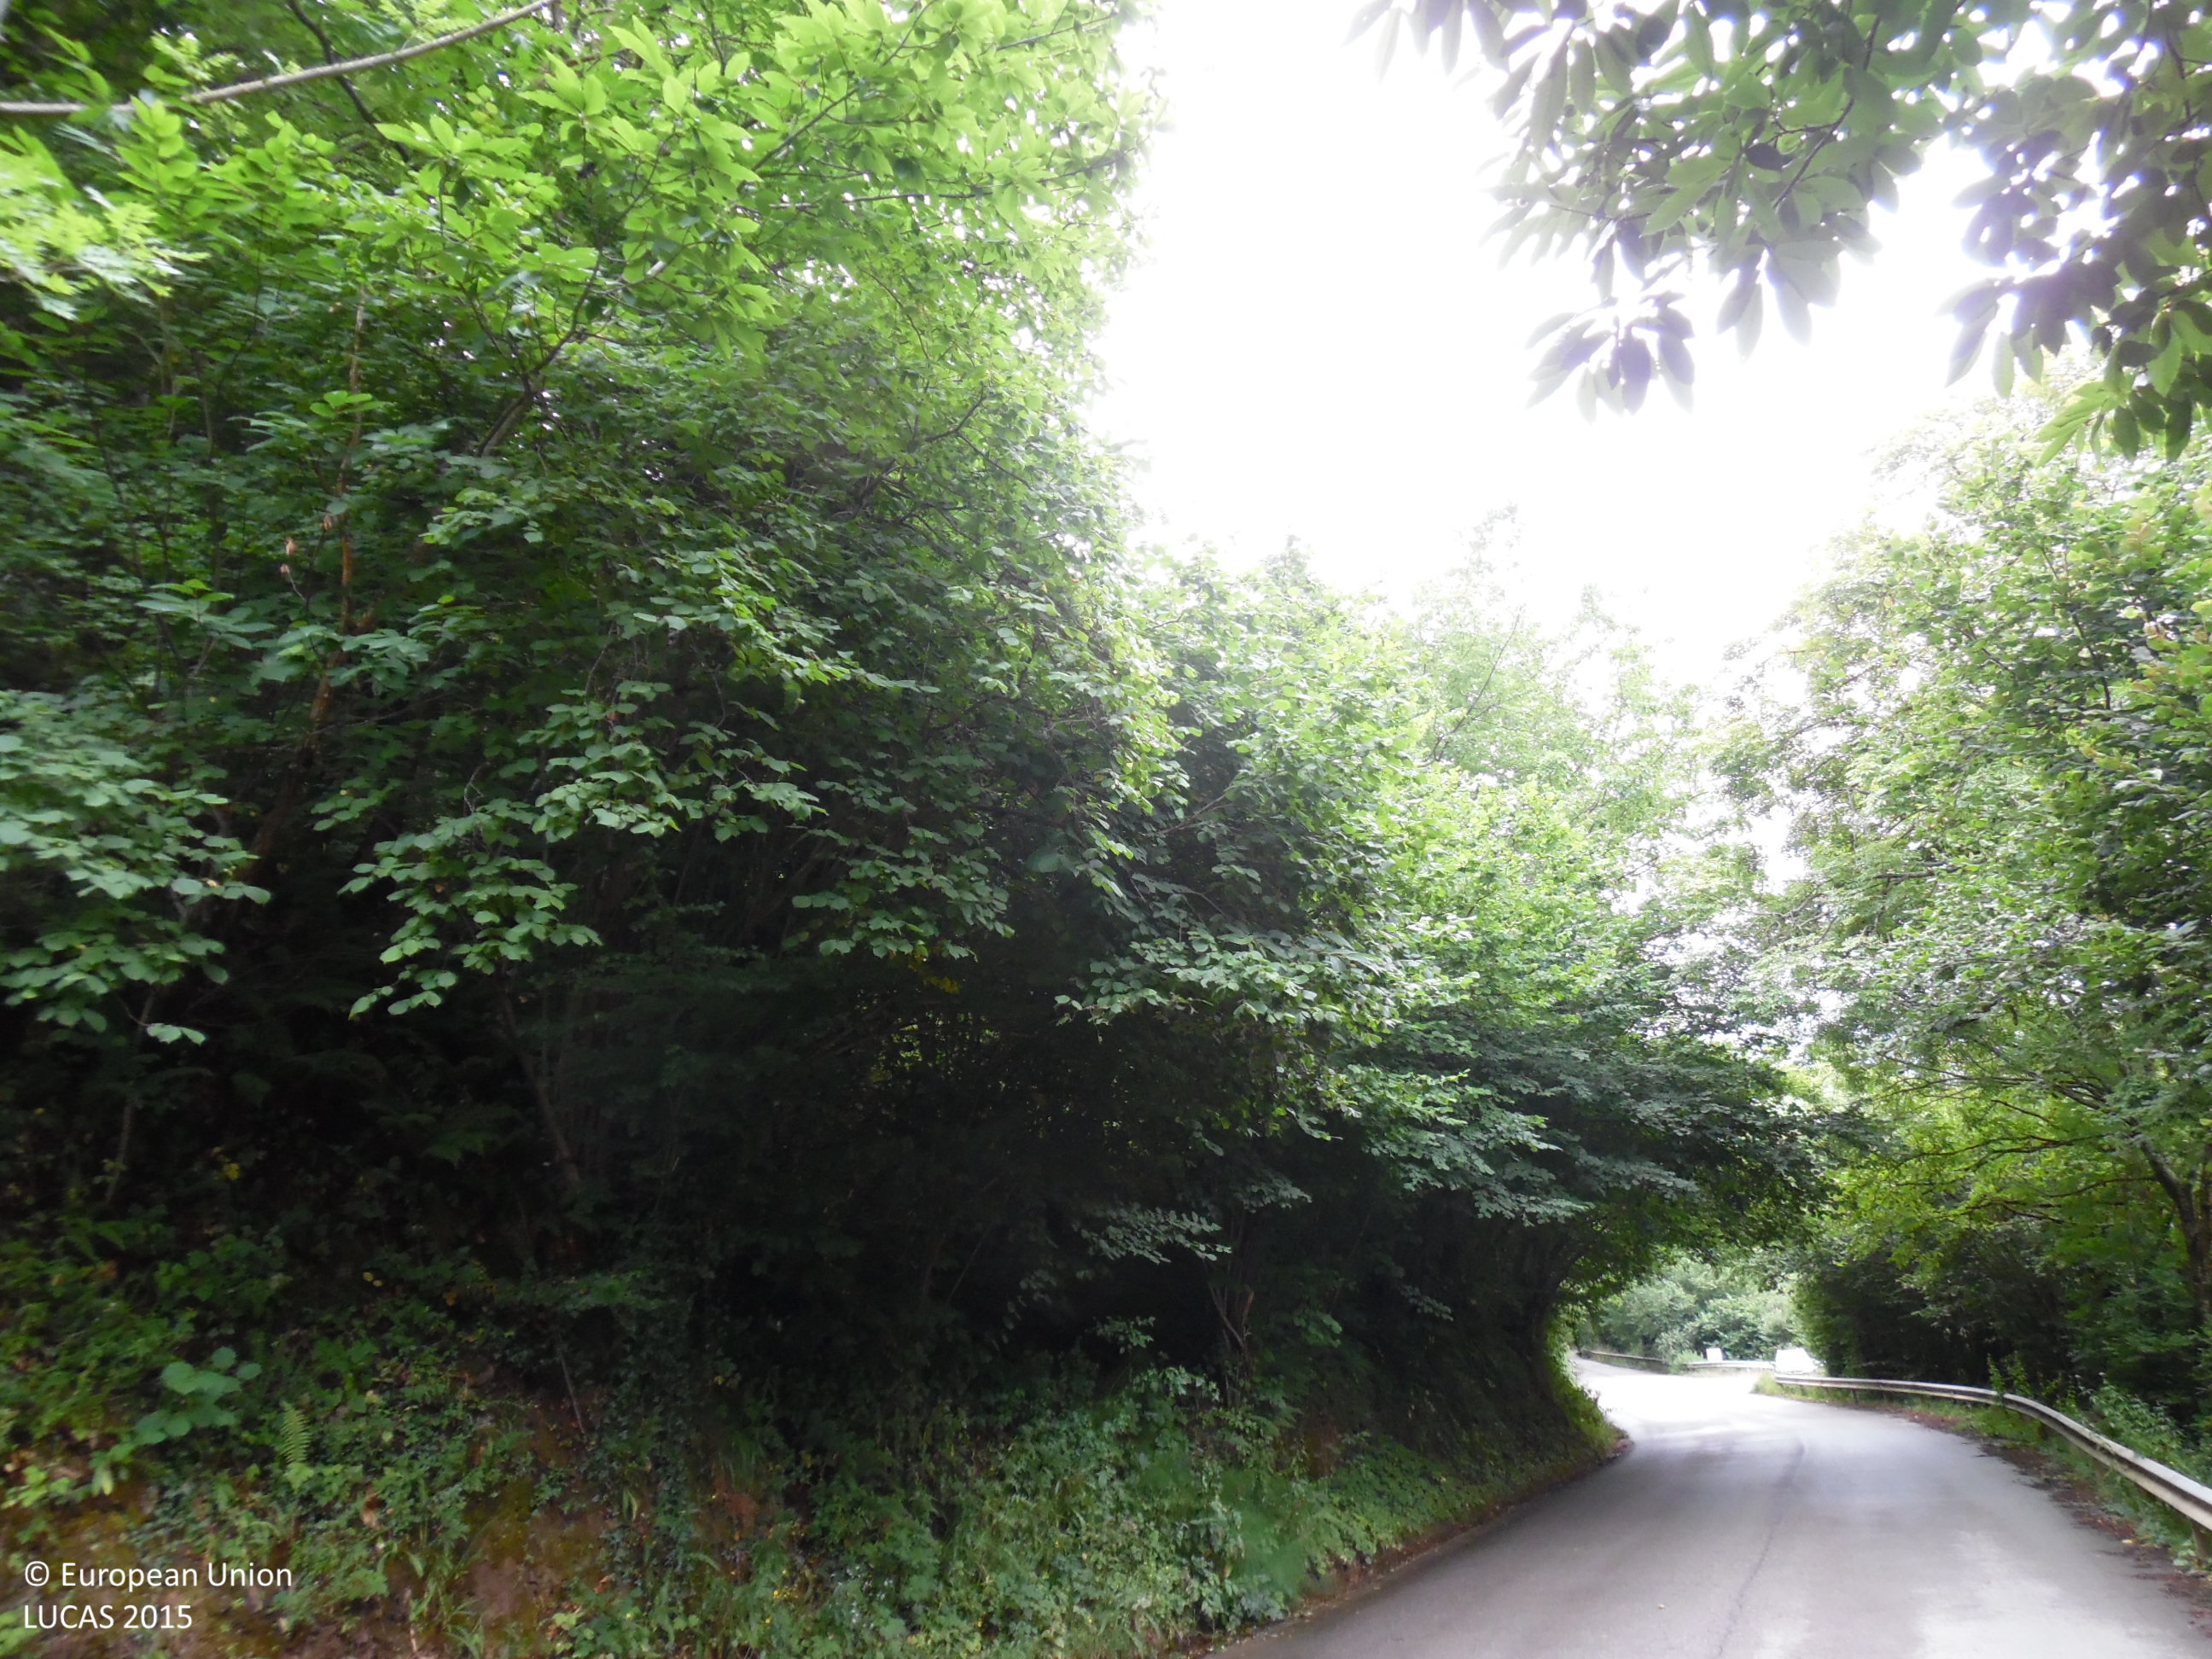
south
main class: Woodland
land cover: Broadleaved woodland
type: thermophilous deciduous forest
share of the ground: > 75 %
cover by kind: broadleaved forest trees 100 %
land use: Forestry
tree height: > 5 m
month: July
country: ES
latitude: 43.0343
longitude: -5.8305
